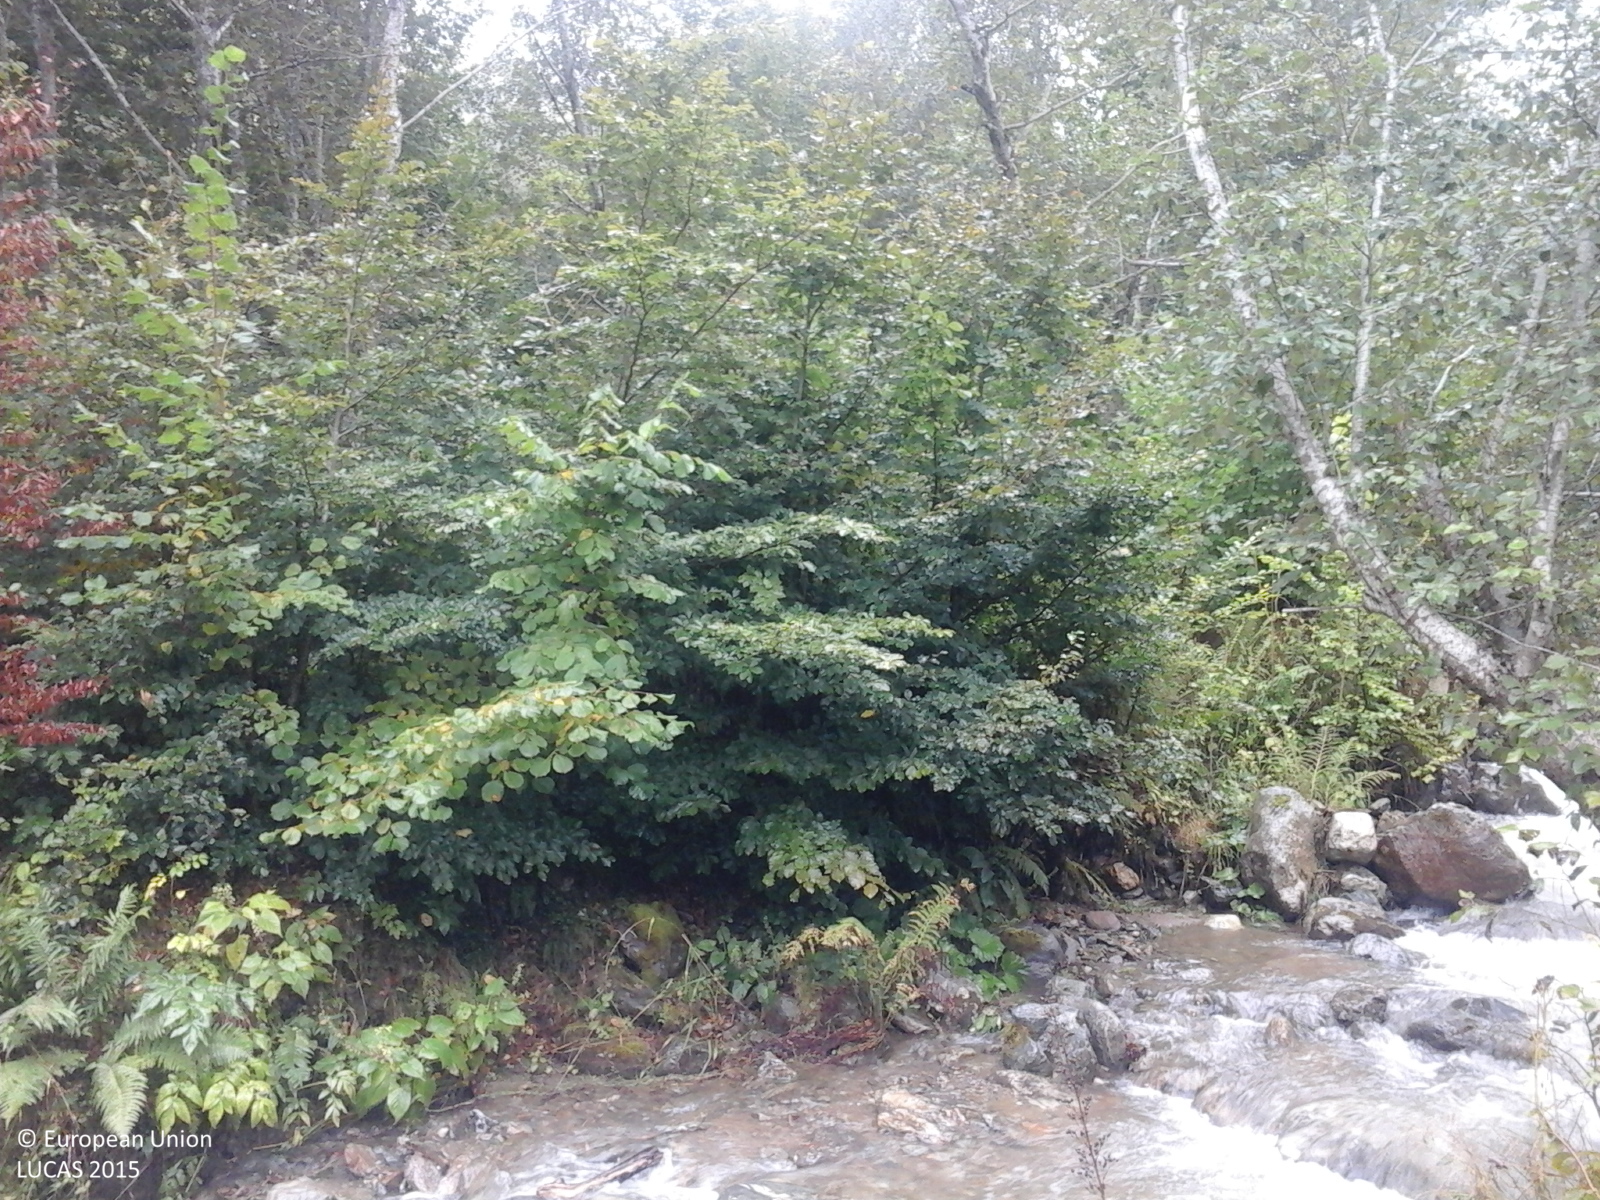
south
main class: Shrubland
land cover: Shrubland with sparse tree cover
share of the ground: > 75 %
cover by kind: herbaceous plants 55 %, shrubs 40 %, broadleaved forest trees 5 %
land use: Forestry
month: September
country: RO
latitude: 45.3526
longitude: 23.9946
